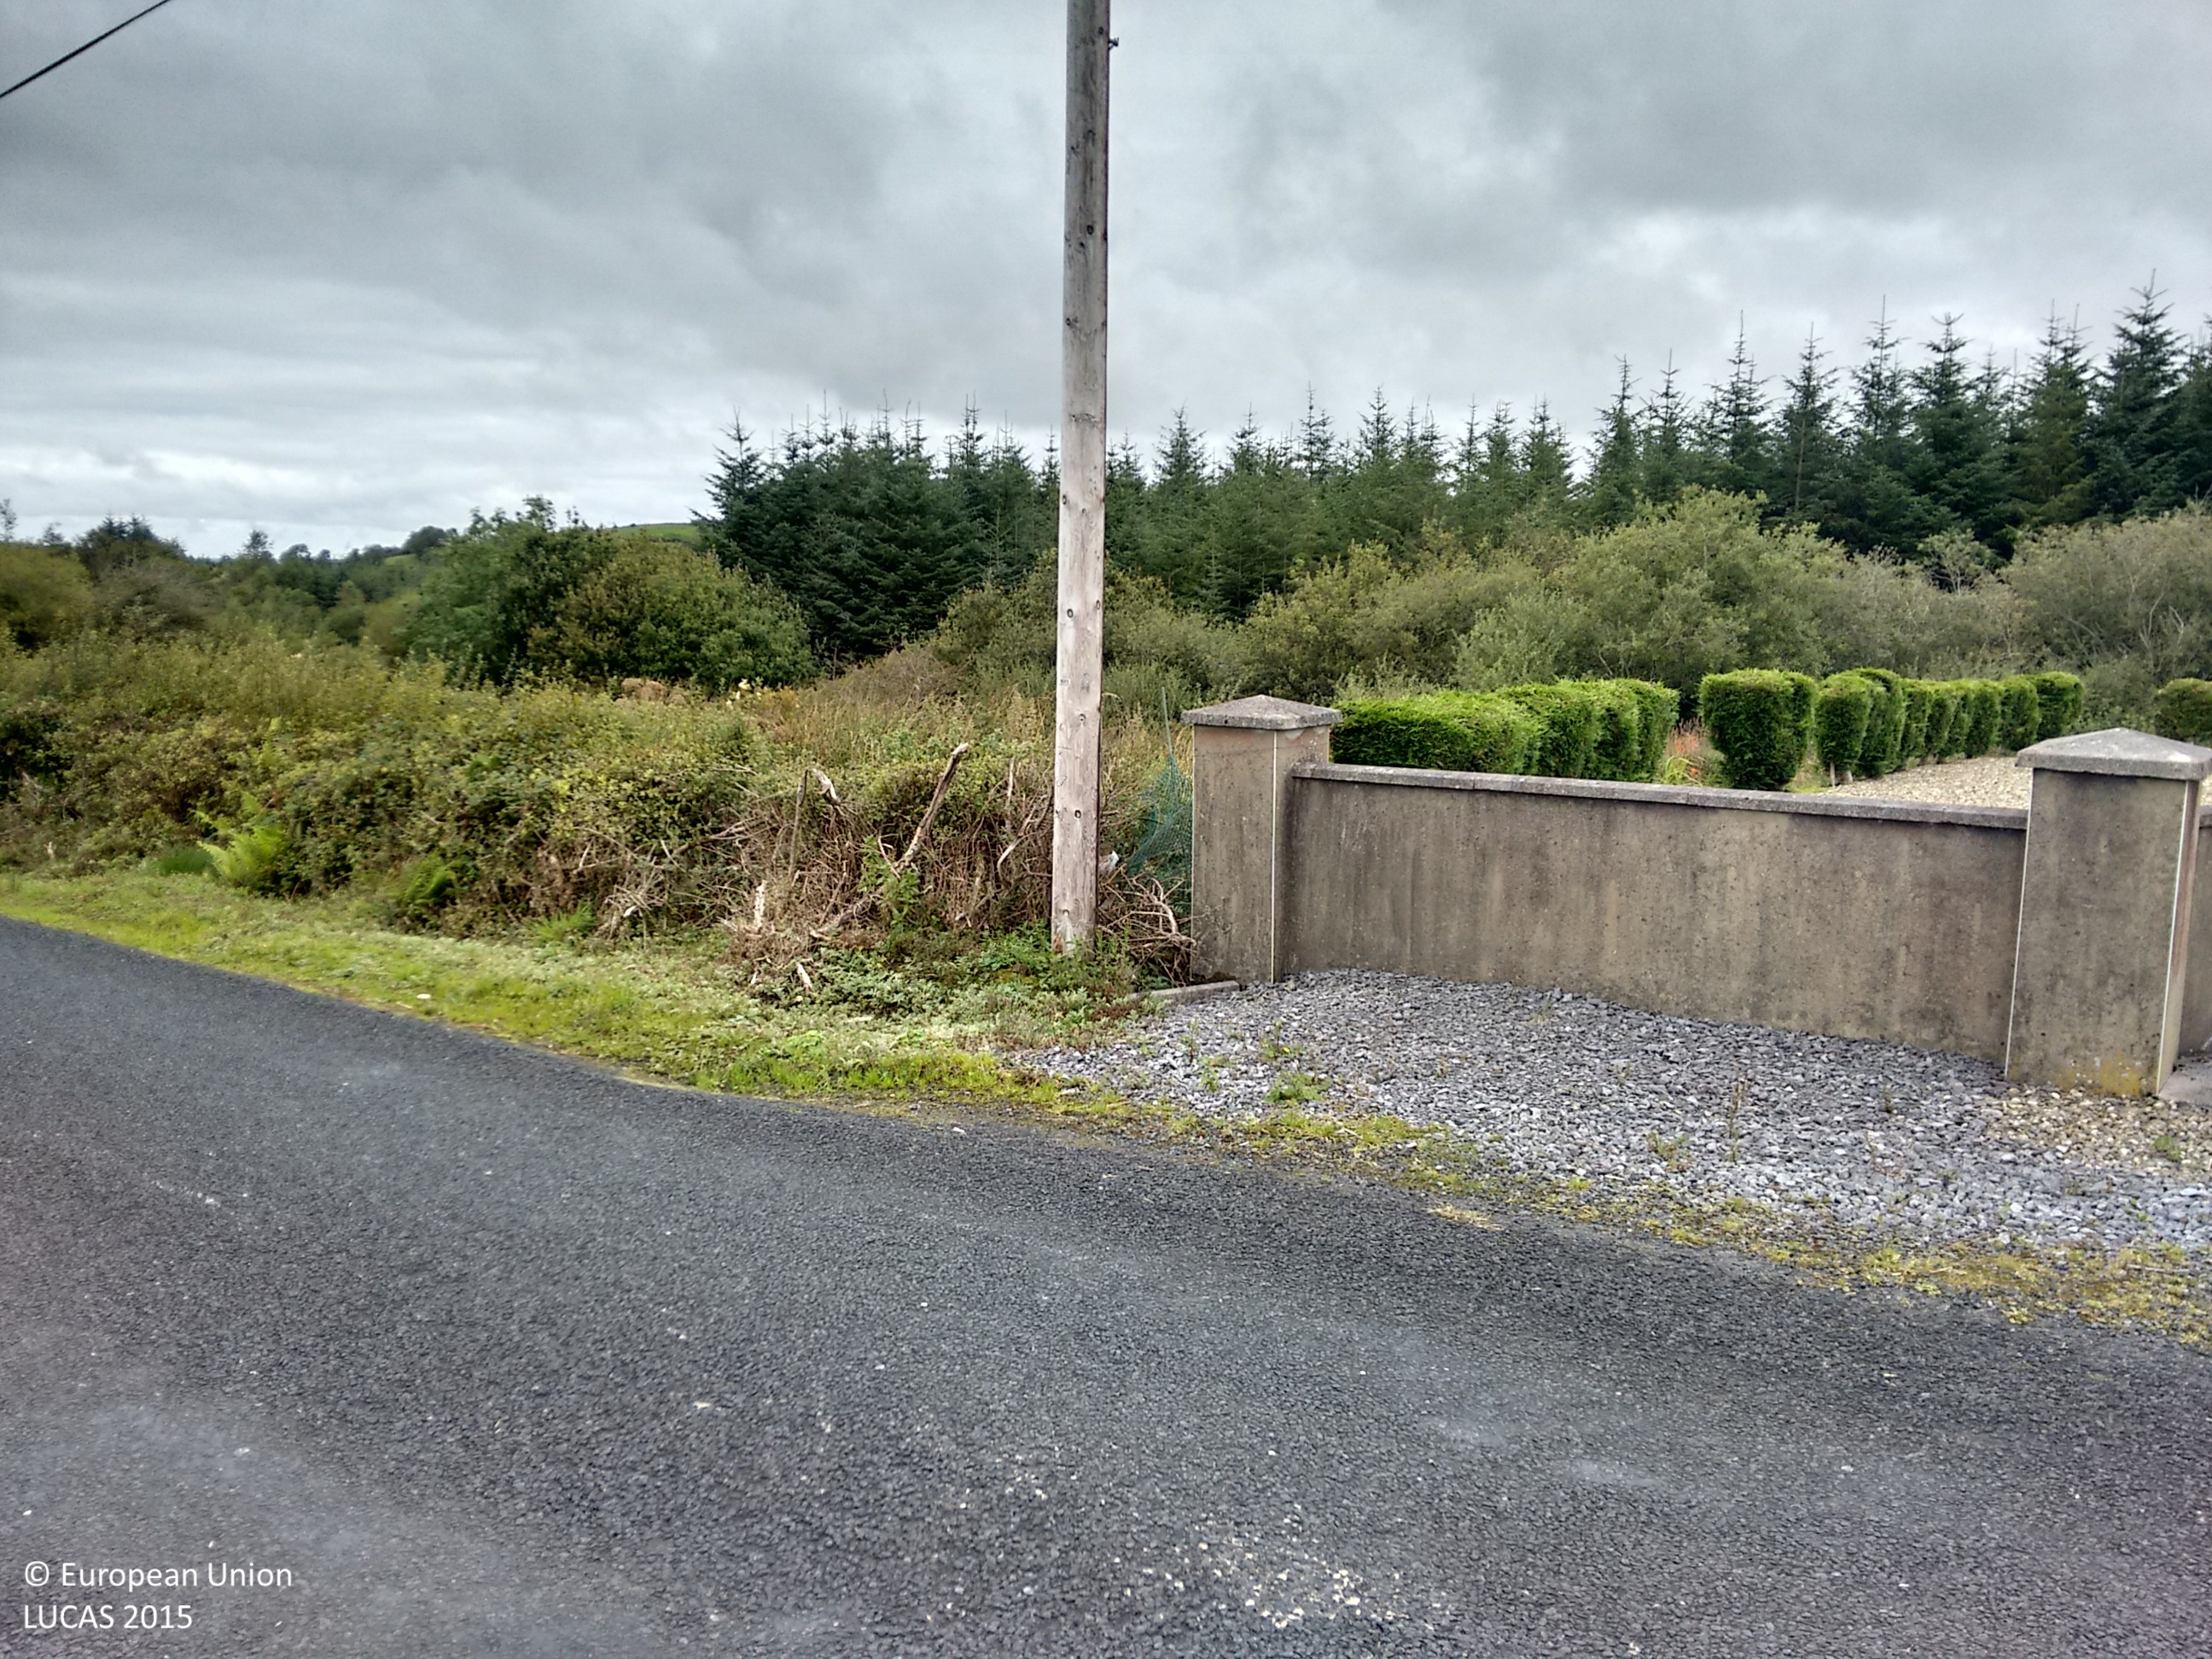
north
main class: Grassland
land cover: Grassland without tree/shrub cover
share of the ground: > 75 %
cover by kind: herbaceous plants 100 %
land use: Agriculture (excluding fallow land and kitchen gardens)
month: September
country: IE
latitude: 52.8338
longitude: -9.1442
